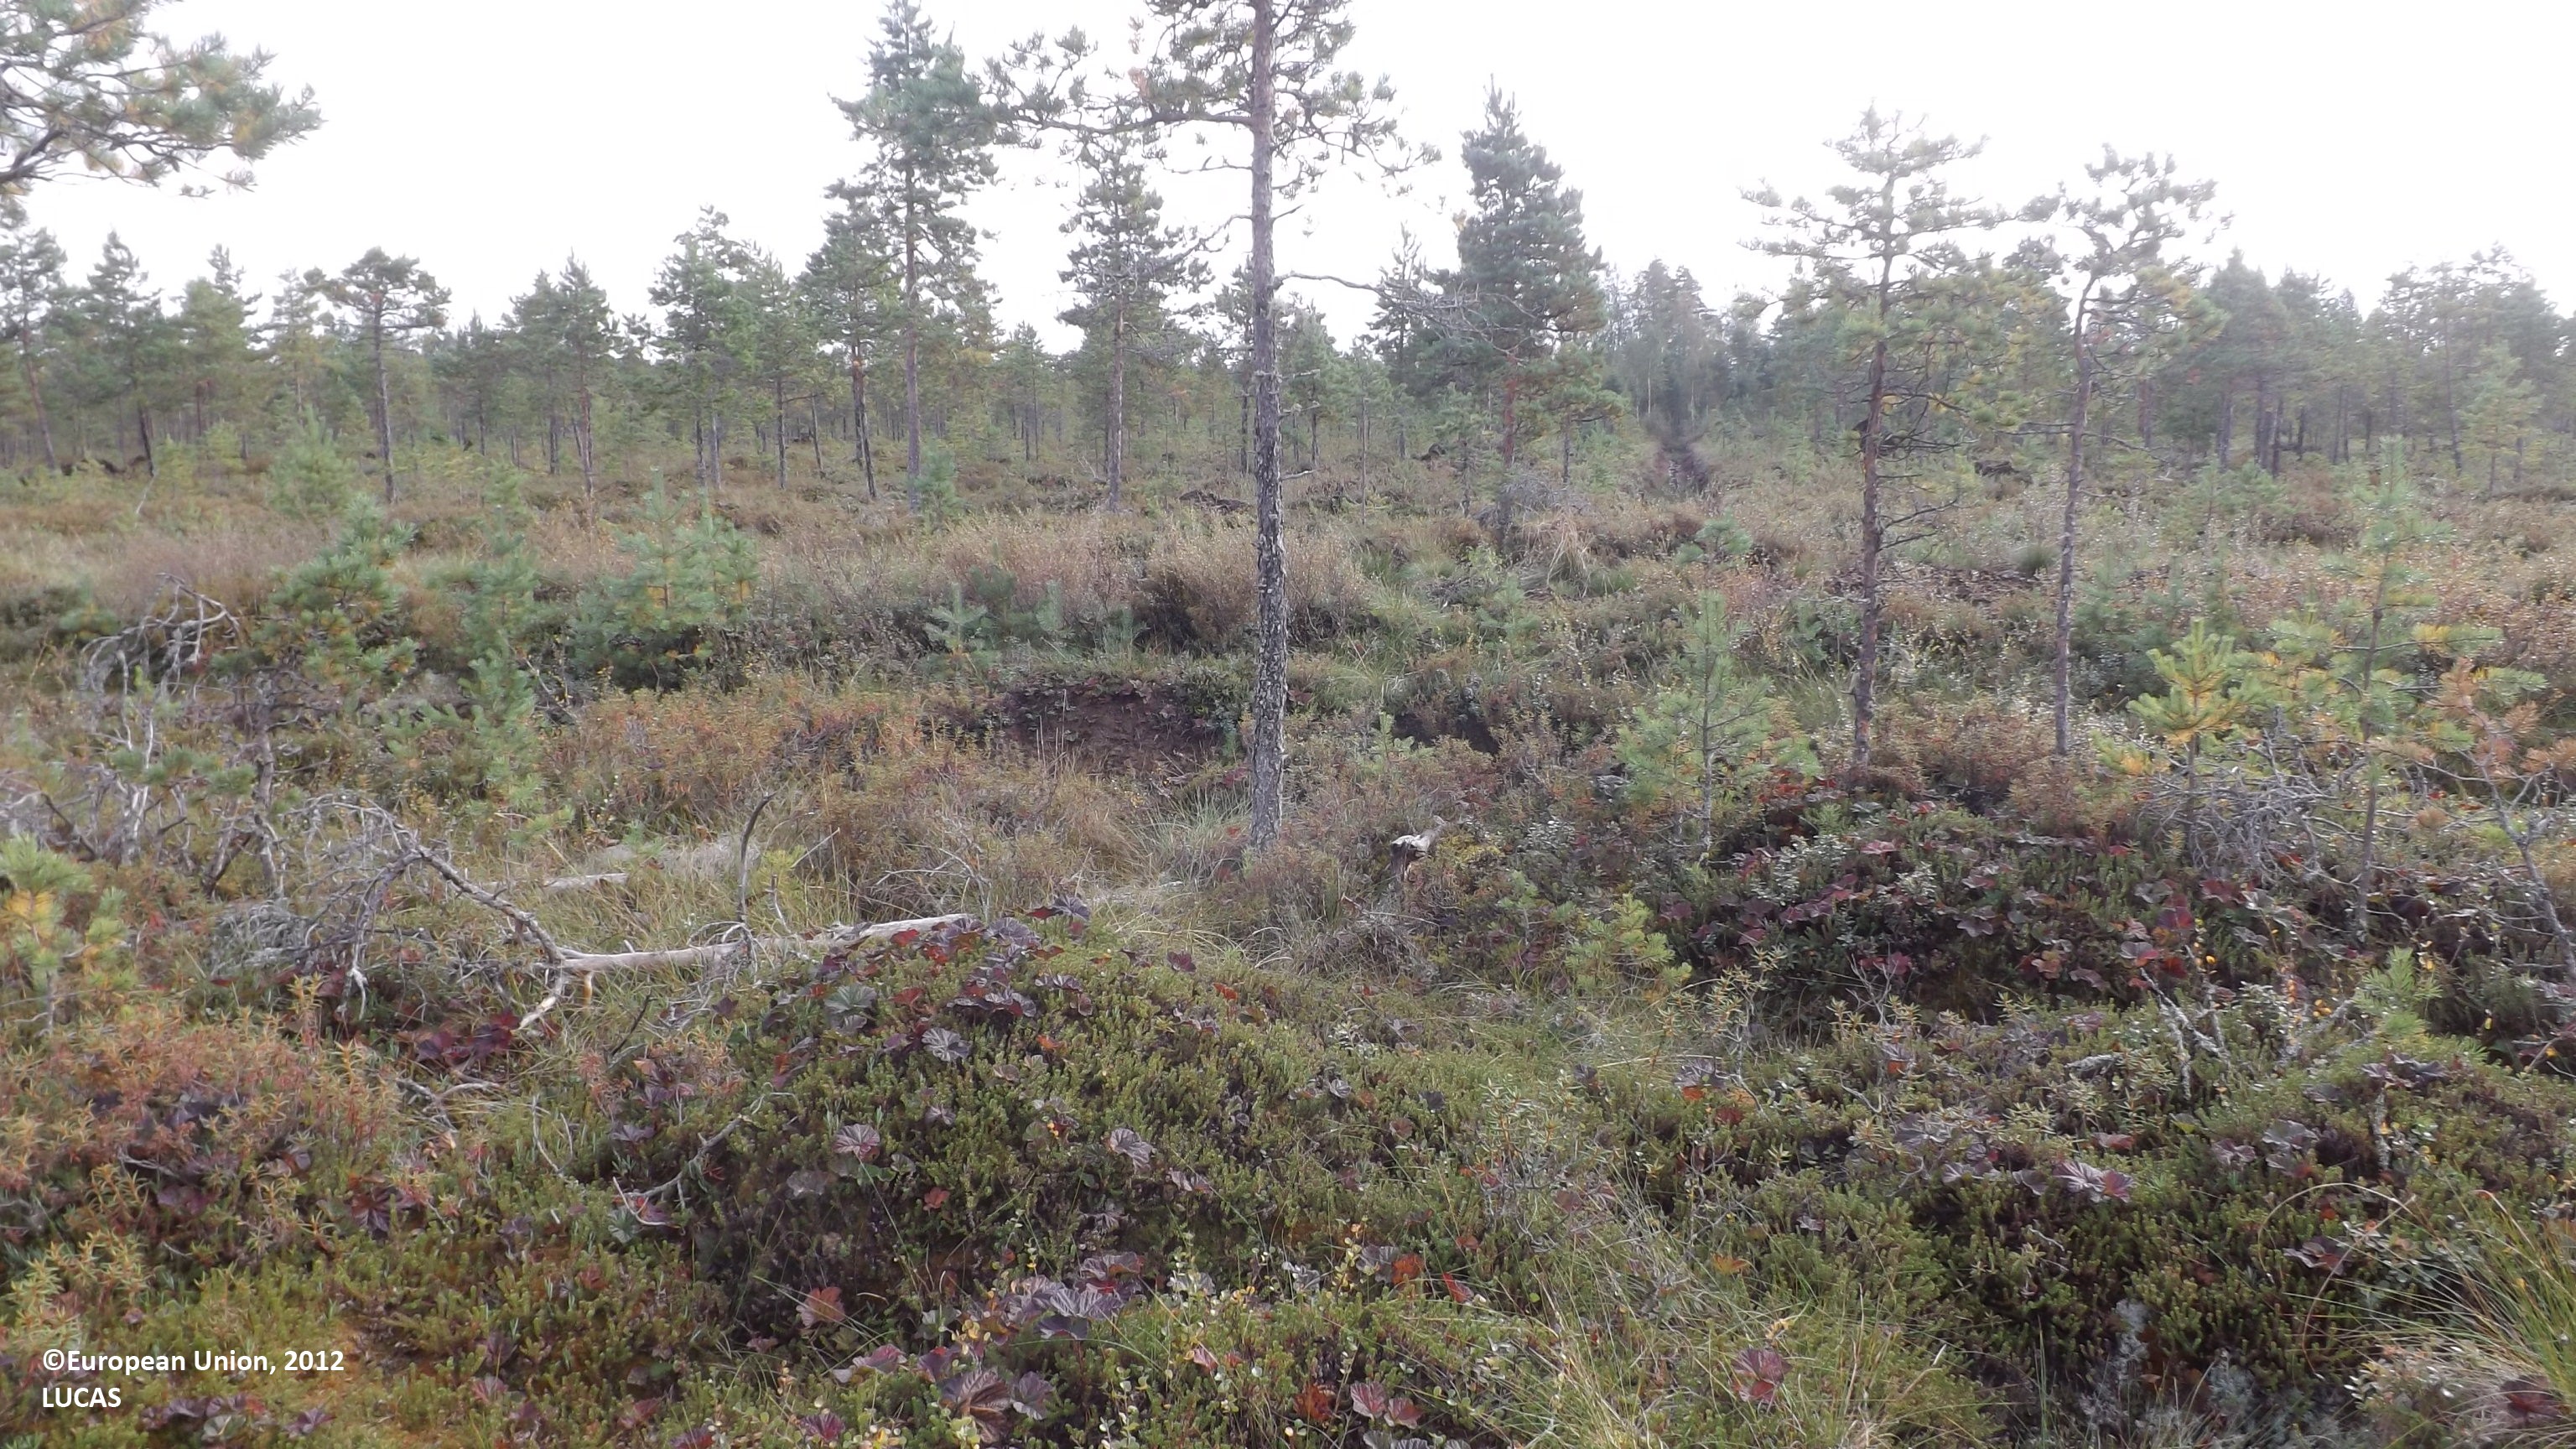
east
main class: Woodland
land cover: Pine dominated coniferous woodland
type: mire and swamp forests
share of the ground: 10 - 25 %
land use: Forestry
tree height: < 5 m
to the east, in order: Pine dominated coniferous woodland; Ditches and canals; Peatbogs; Pine dominated coniferous woodland; Ditches and canals; Pine dominated coniferous woodland; Peatbogs; Pine dominated coniferous woodland; Ditches and canals; Pine dominated coniferous woodland; Peatbogs; Ditches and canals; Peatbogs
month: August
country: FI
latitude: 63.8617
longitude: 23.6309
